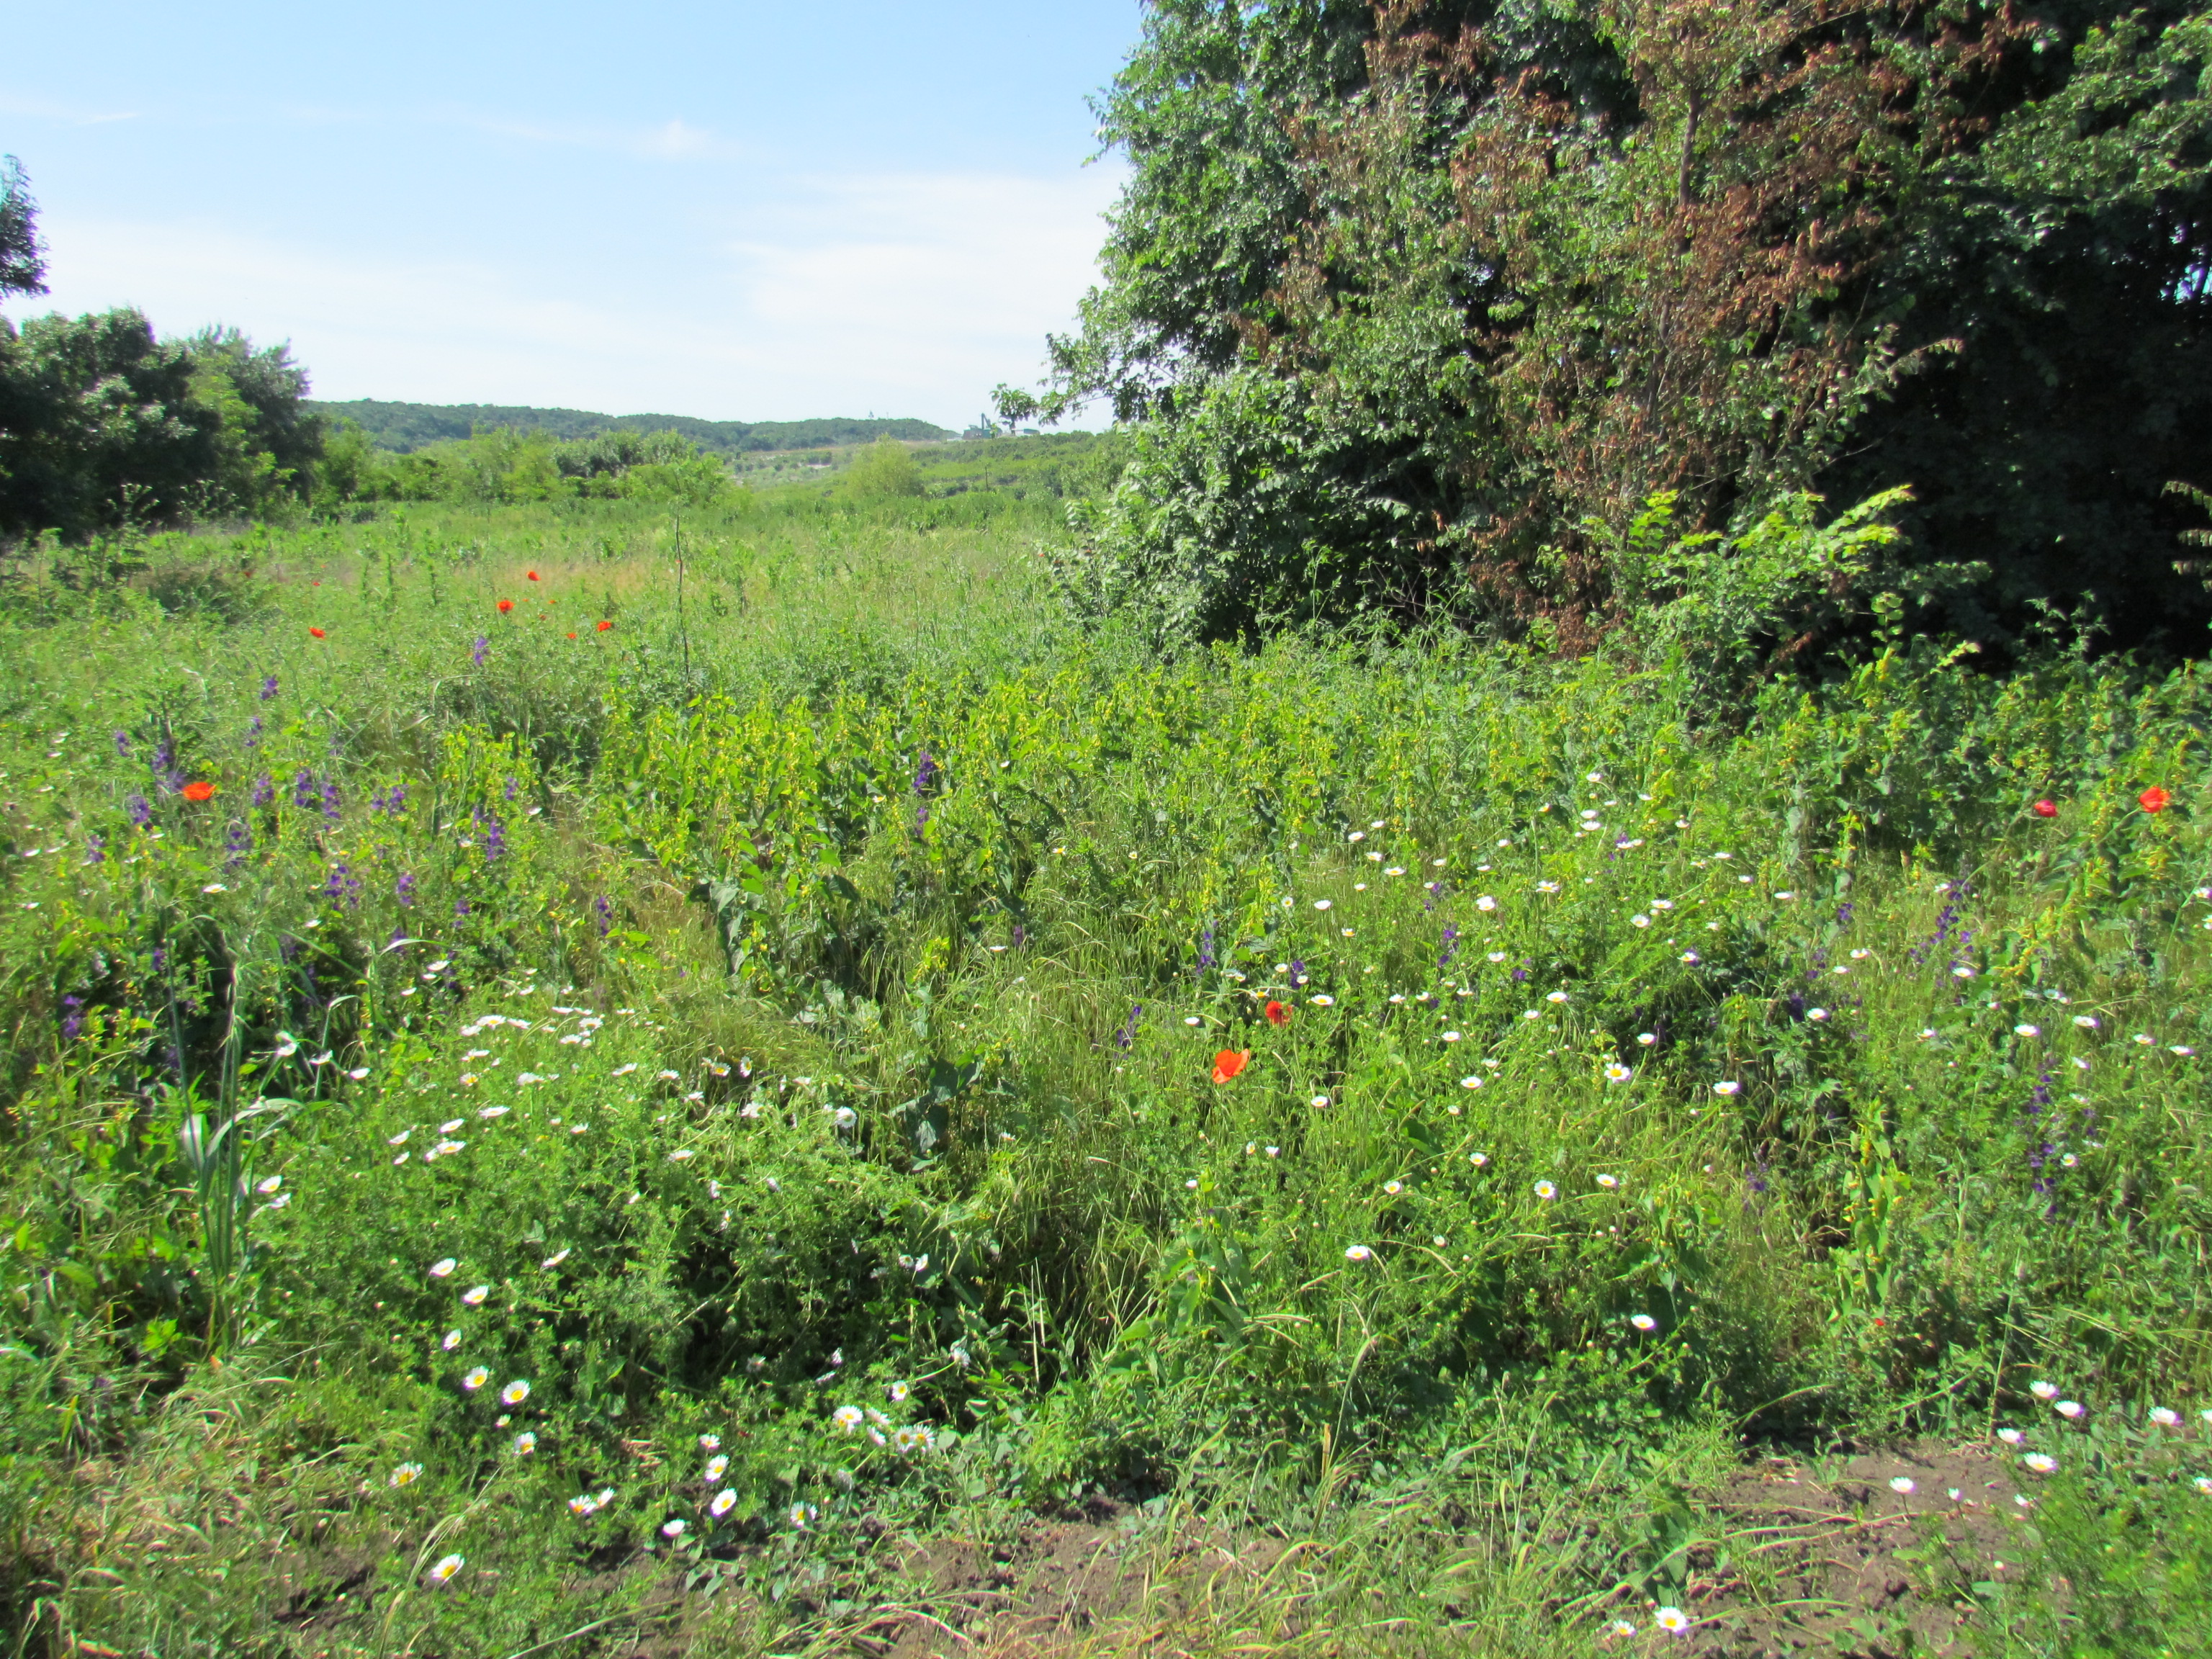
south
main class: Cropland
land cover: Sunflower
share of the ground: 10 - 25 %
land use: Agriculture (excluding fallow land and kitchen gardens)
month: June
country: BG
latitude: 42.4961
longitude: 27.3056
